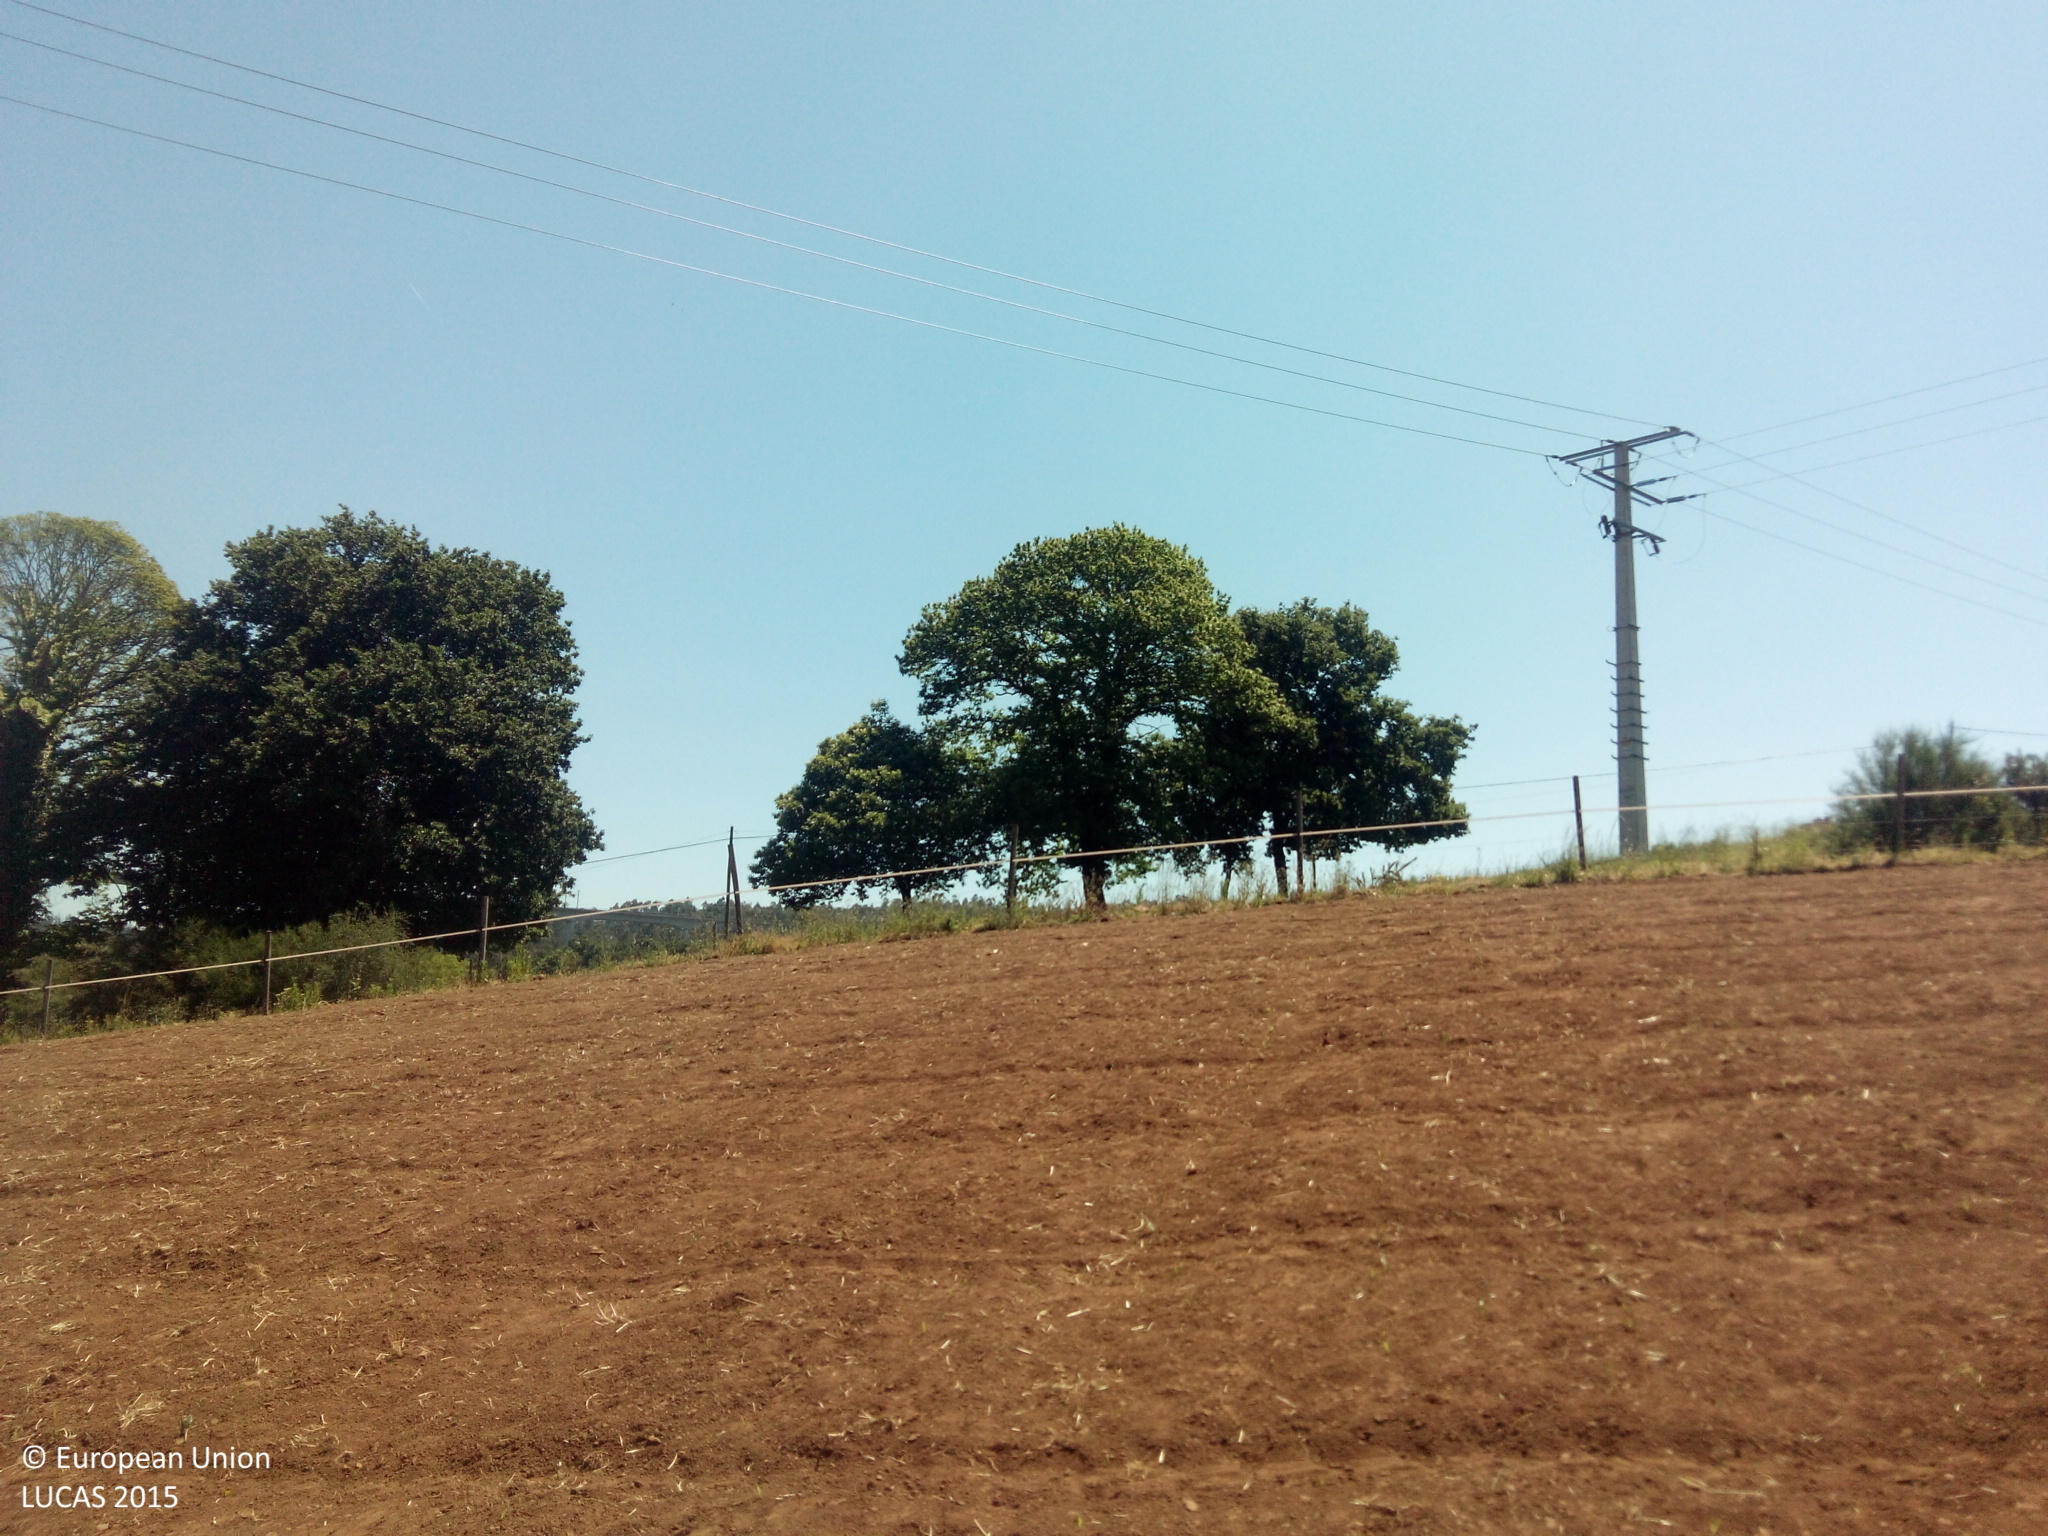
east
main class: Cropland
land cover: Maize
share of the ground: < 10 %
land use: Agriculture (excluding fallow land and kitchen gardens)
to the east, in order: Maize; Fences; Artificial constructions; Ditches and canals; Paved roads, cycling and walking lanes; Ditches and canals; Artificial constructions; Fences; Electric lines; Shrubland with sparse tree cover; Spontaneously vegetated surfaces; Electric lines; Spontaneously vegetated surfaces; Managed hedges; Ditches and canals; Paved roads, cycling and walking lanes; Fences; Spontaneously vegetated surfaces; Broadleaved woodland
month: May
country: ES
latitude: 42.8239
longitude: -8.4615
